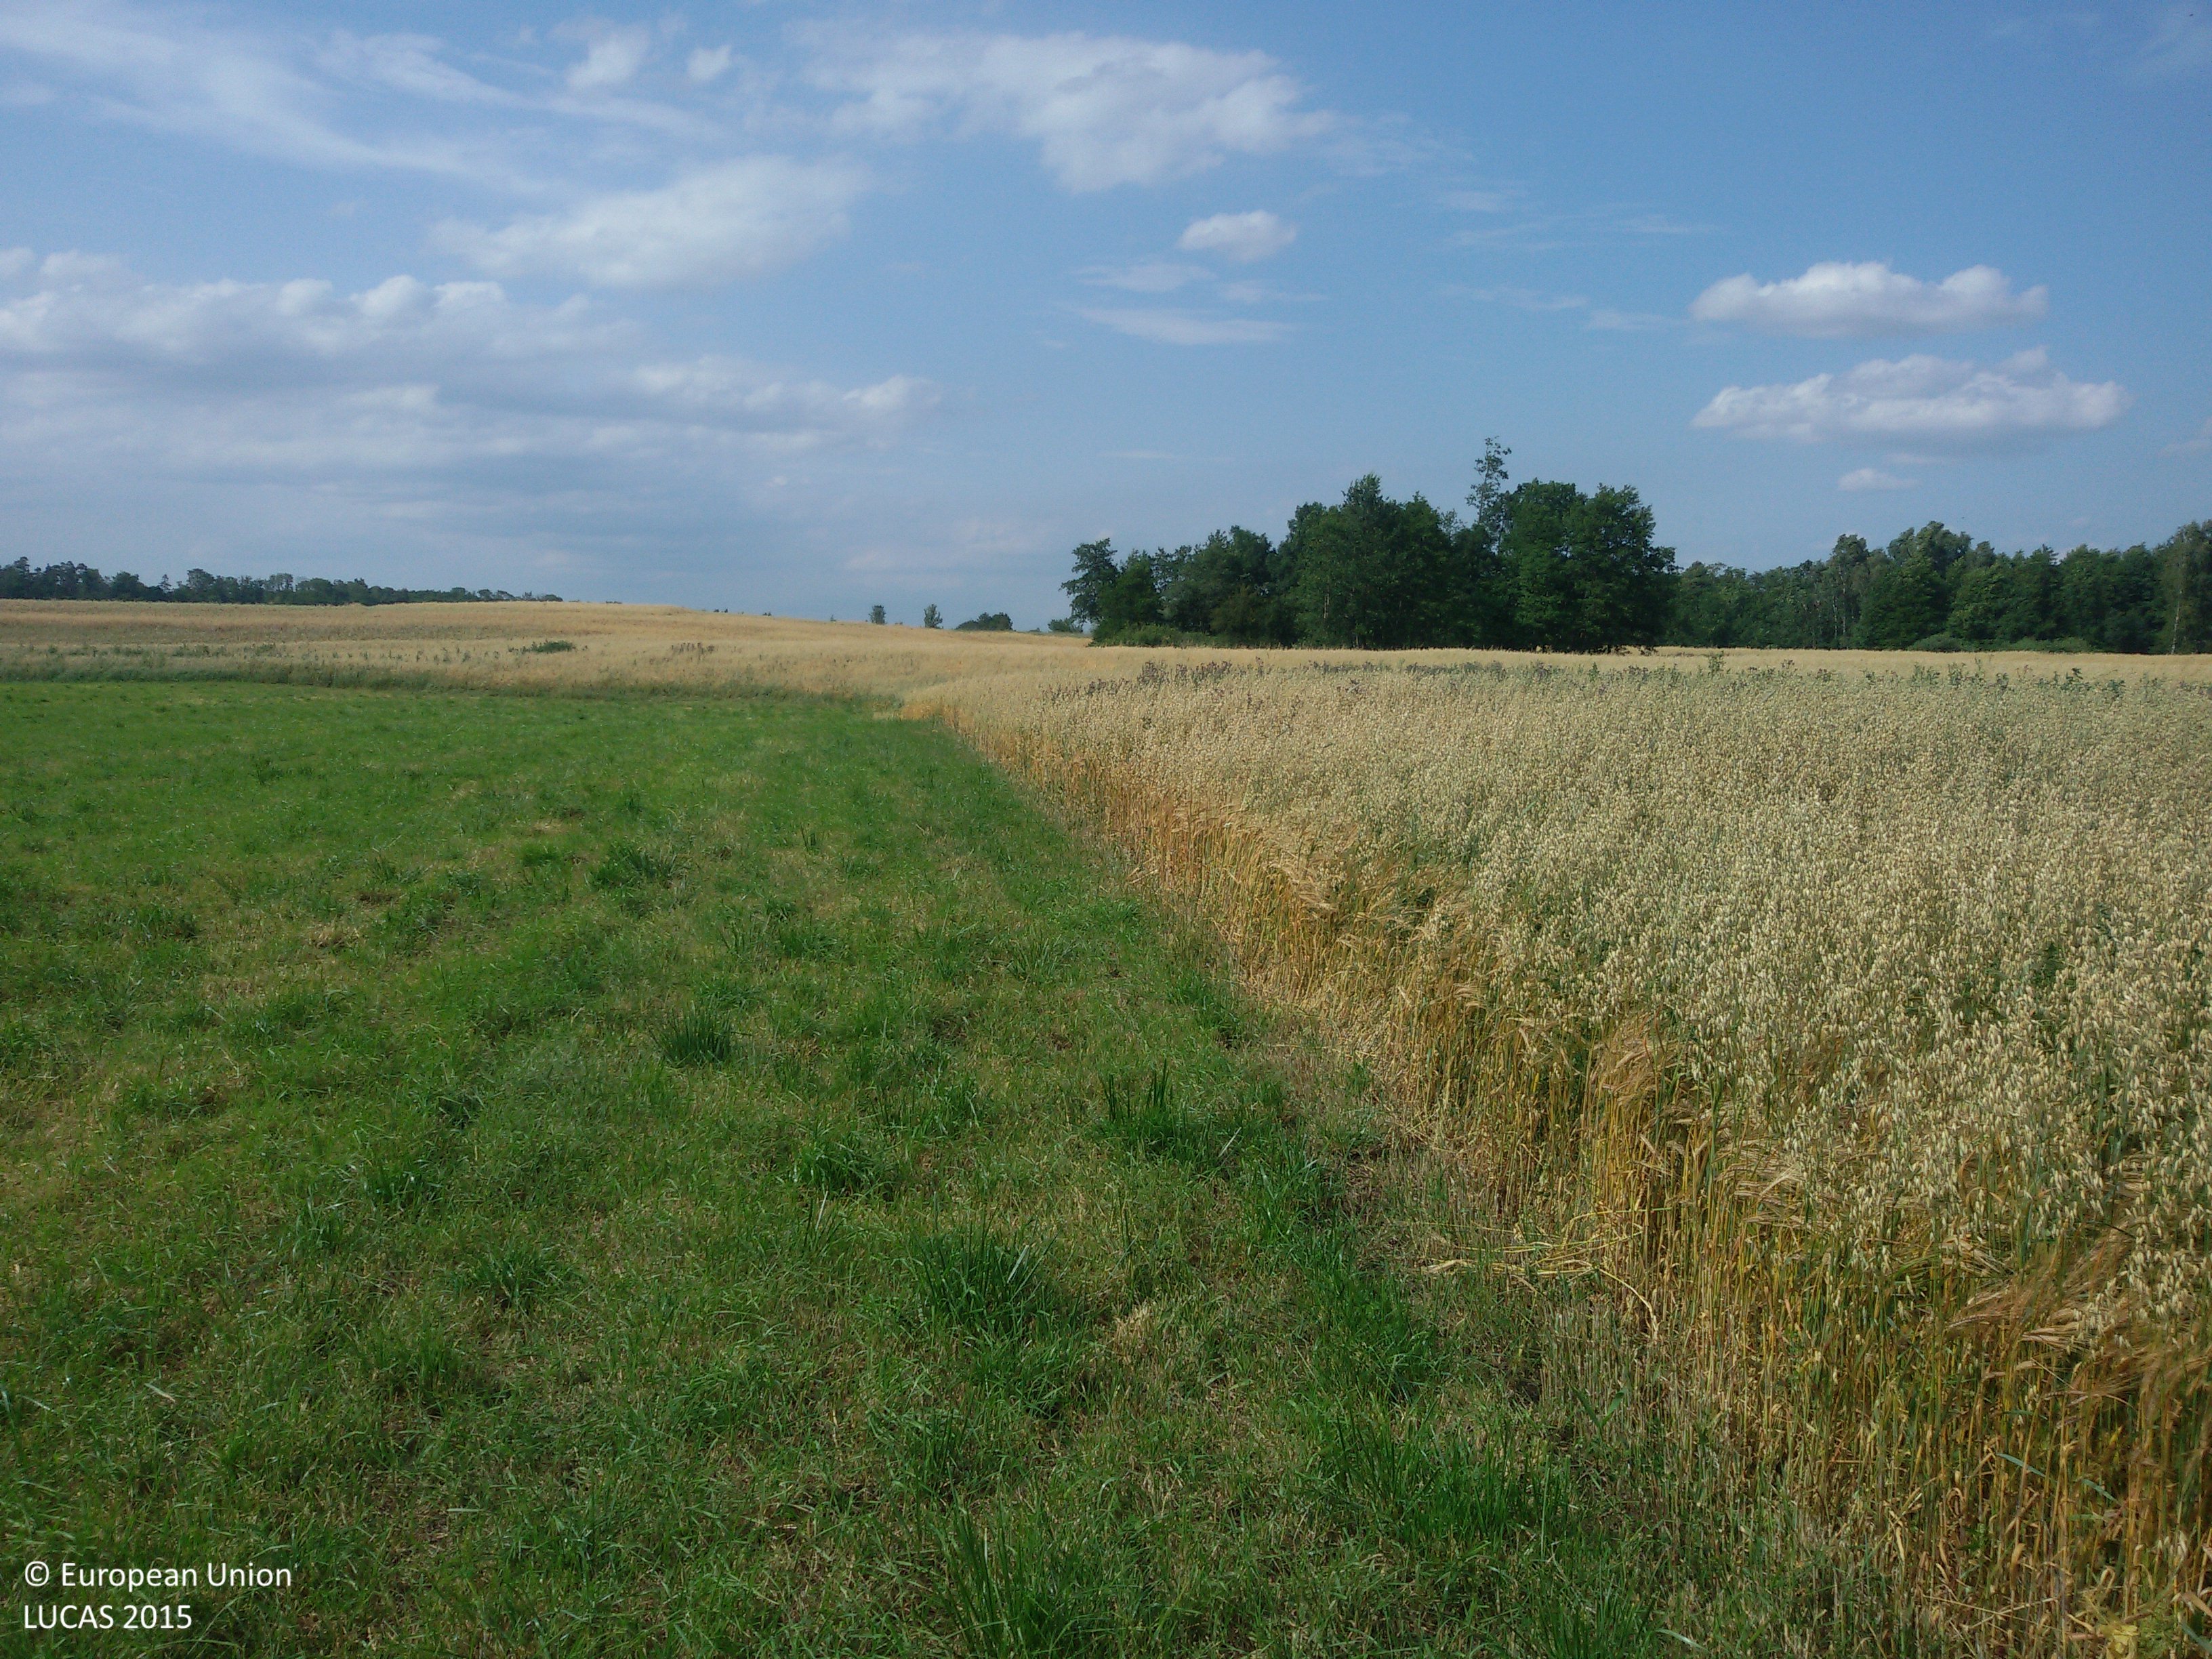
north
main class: Grassland
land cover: Grassland without tree/shrub cover
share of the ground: > 75 %
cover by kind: herbaceous plants 100 %
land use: Agriculture (excluding fallow land and kitchen gardens)
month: July
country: PL
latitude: 53.3718
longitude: 17.7236
